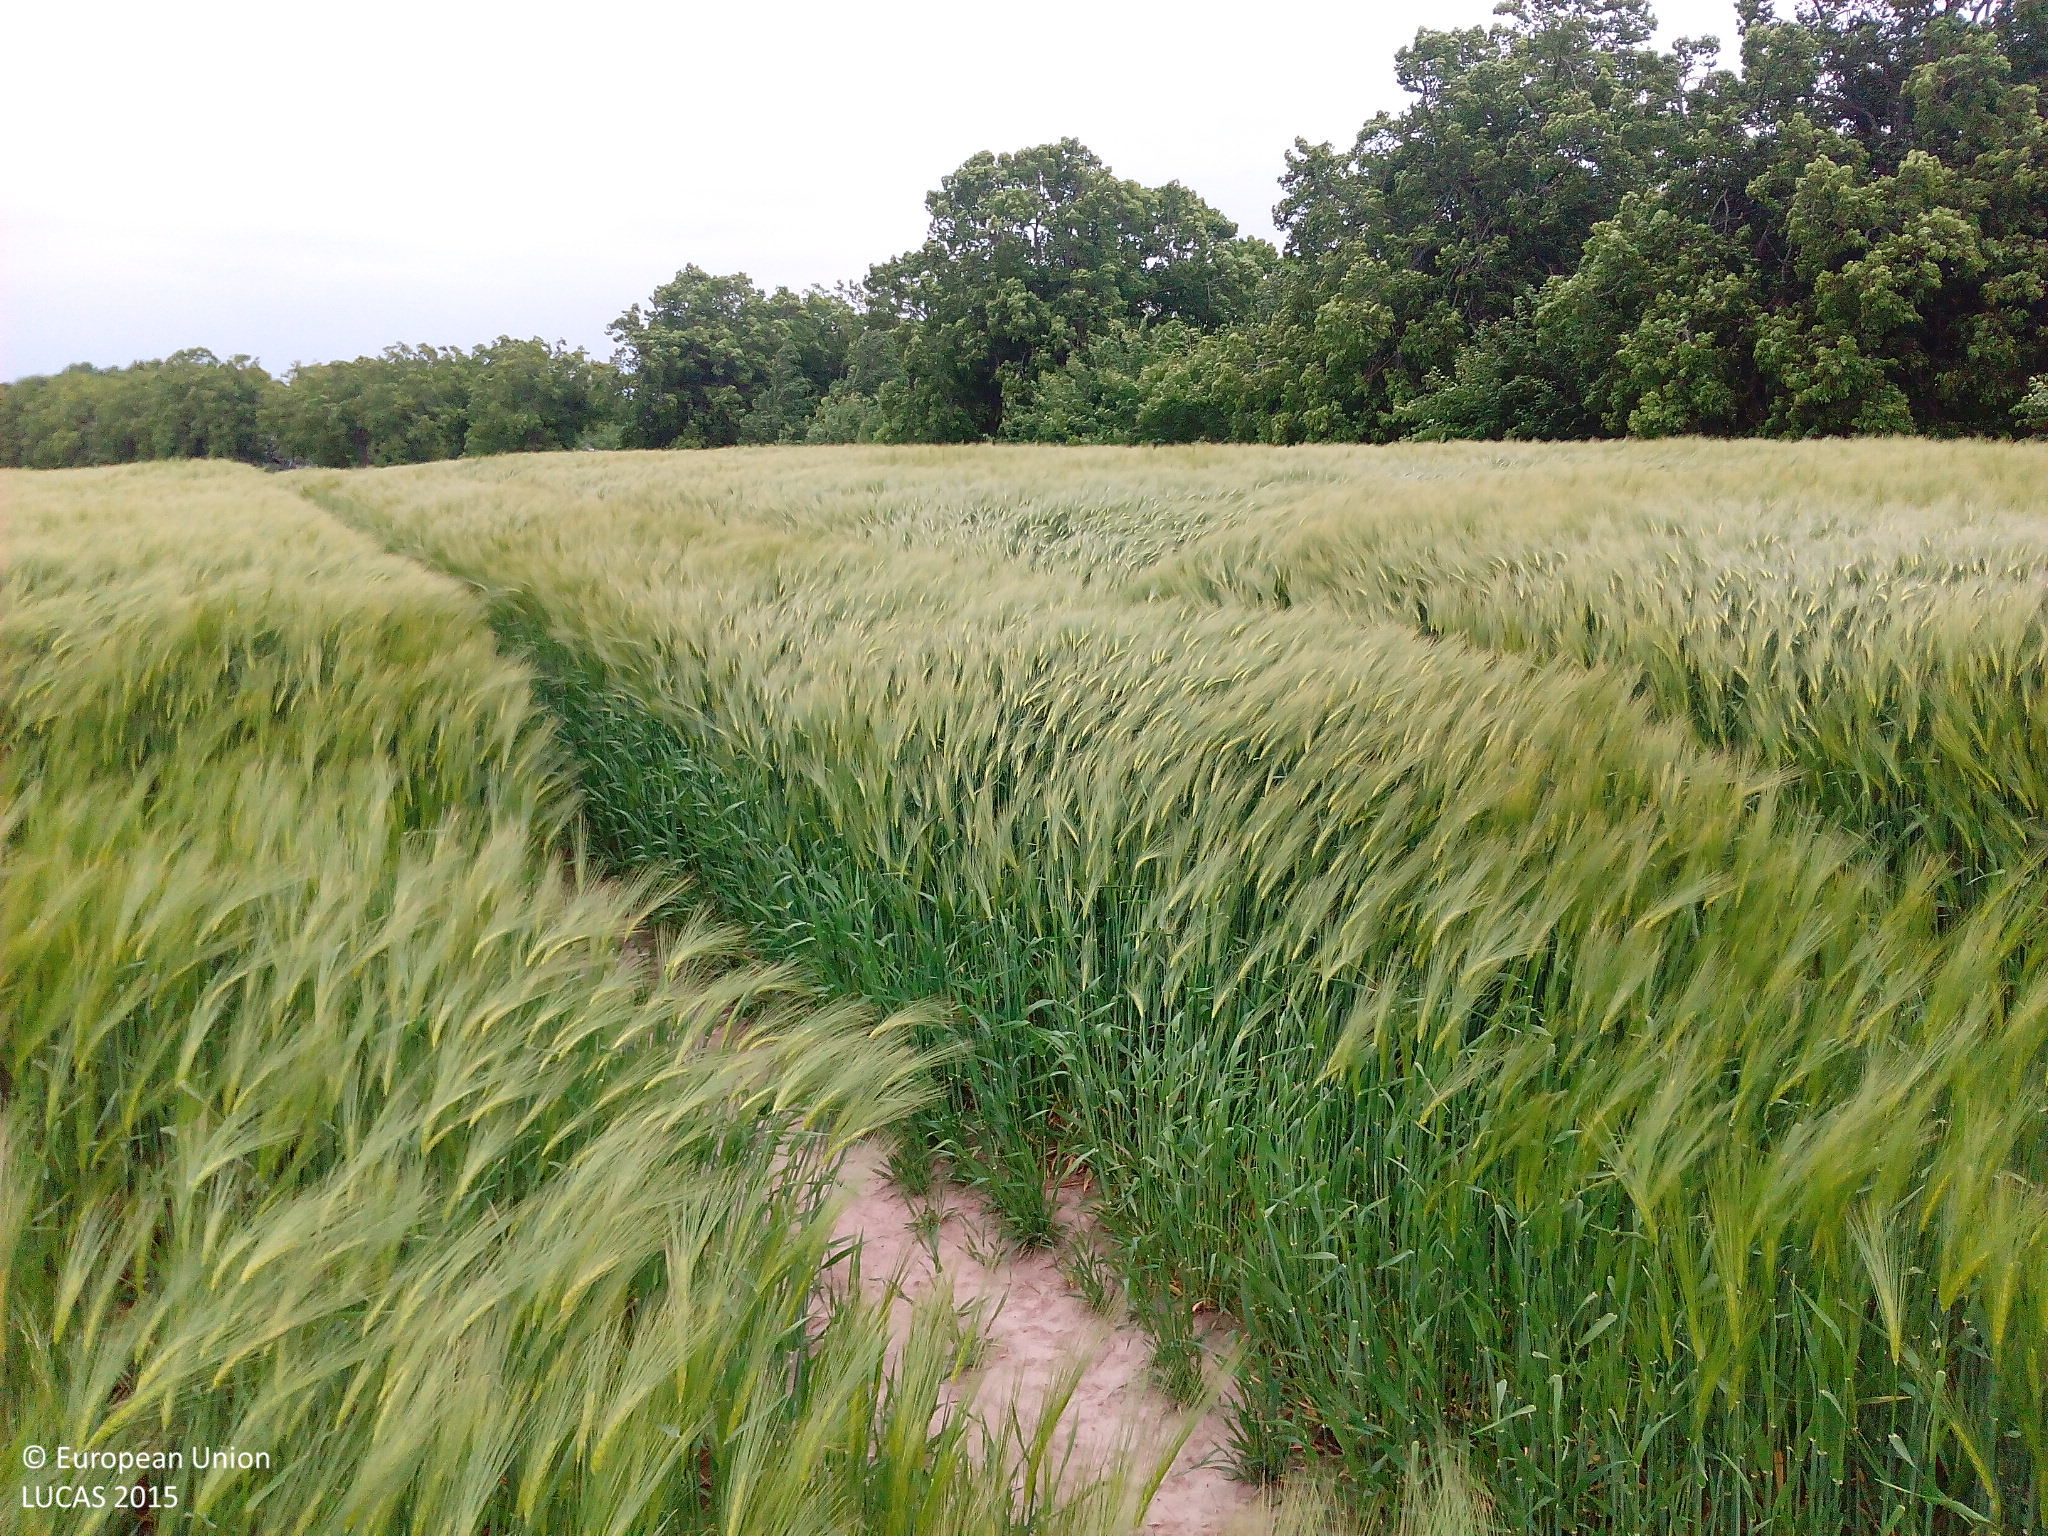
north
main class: Cropland
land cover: Barley
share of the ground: > 75 %
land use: Agriculture (excluding fallow land and kitchen gardens)
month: June
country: DE
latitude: 54.2923
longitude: 13.3024
